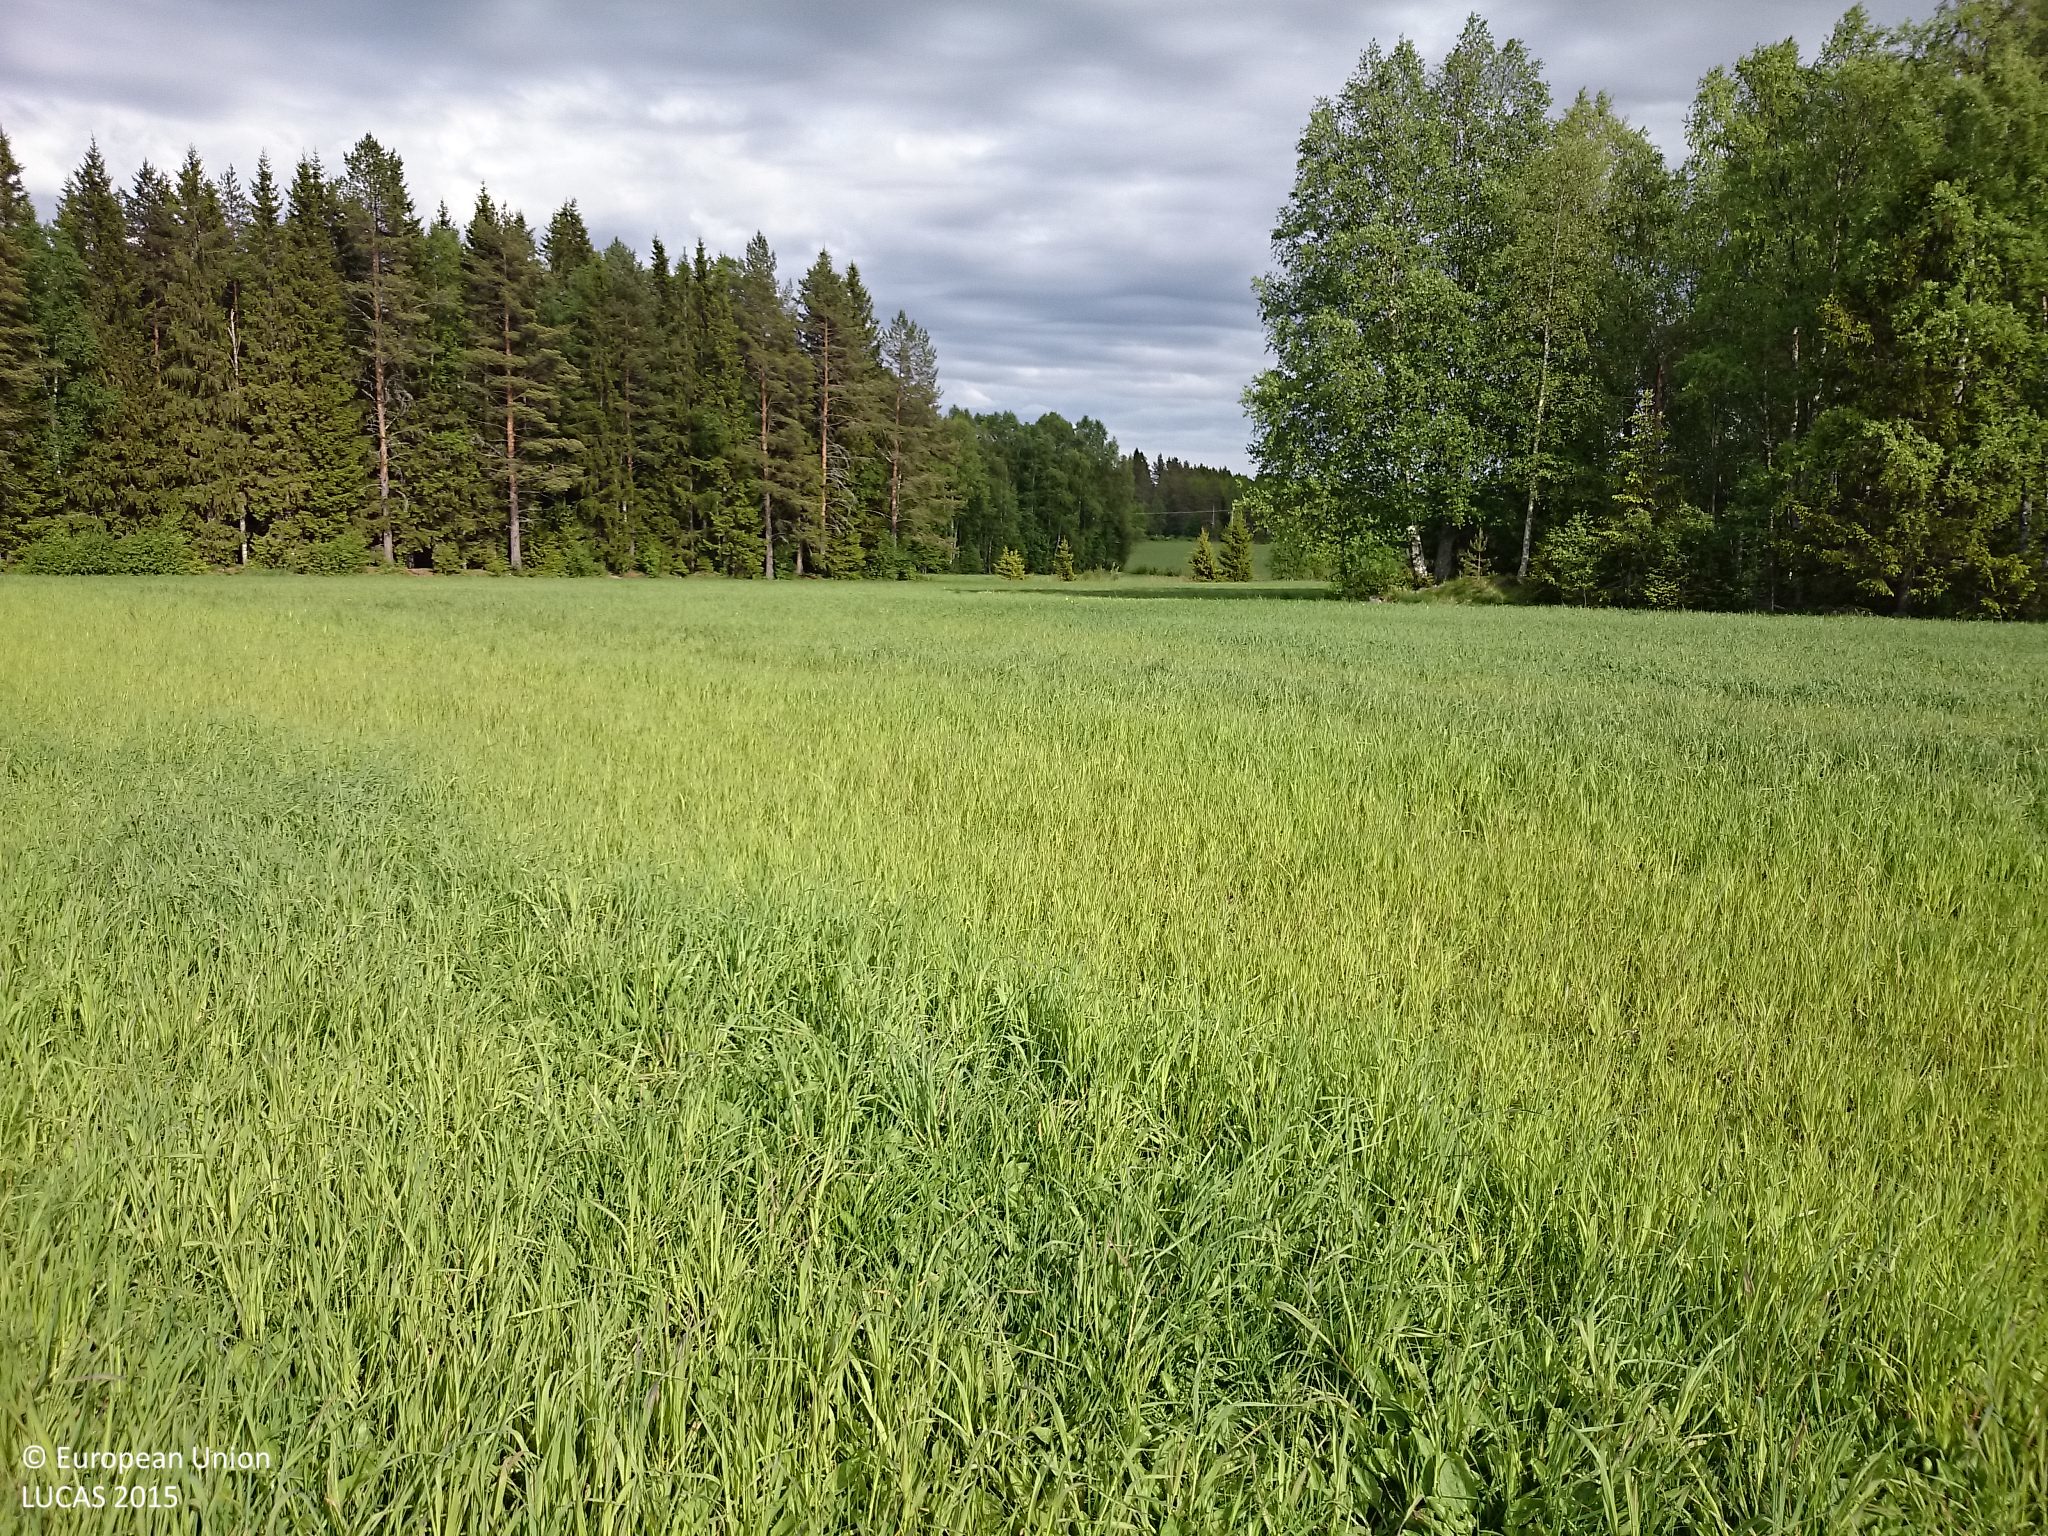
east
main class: Cropland
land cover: Mixed cereals for fodder
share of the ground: > 75 %
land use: Agriculture (excluding fallow land and kitchen gardens)
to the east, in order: Mixed cereals for fodder; Ditches and canals; Other mixed woodland; Spruce dominated coniferous woodland; Other mixed woodland; Ditches and canals; Spruce dominated coniferous woodland; Other mixed woodland; Ditches and canals; Broadleaved woodland; Other bare soil; Abandoned hedges; Ditches and canals; Abandoned hedges; Grassland without tree/shrub cover
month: June
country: SE
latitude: 64.0870
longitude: 20.7505
